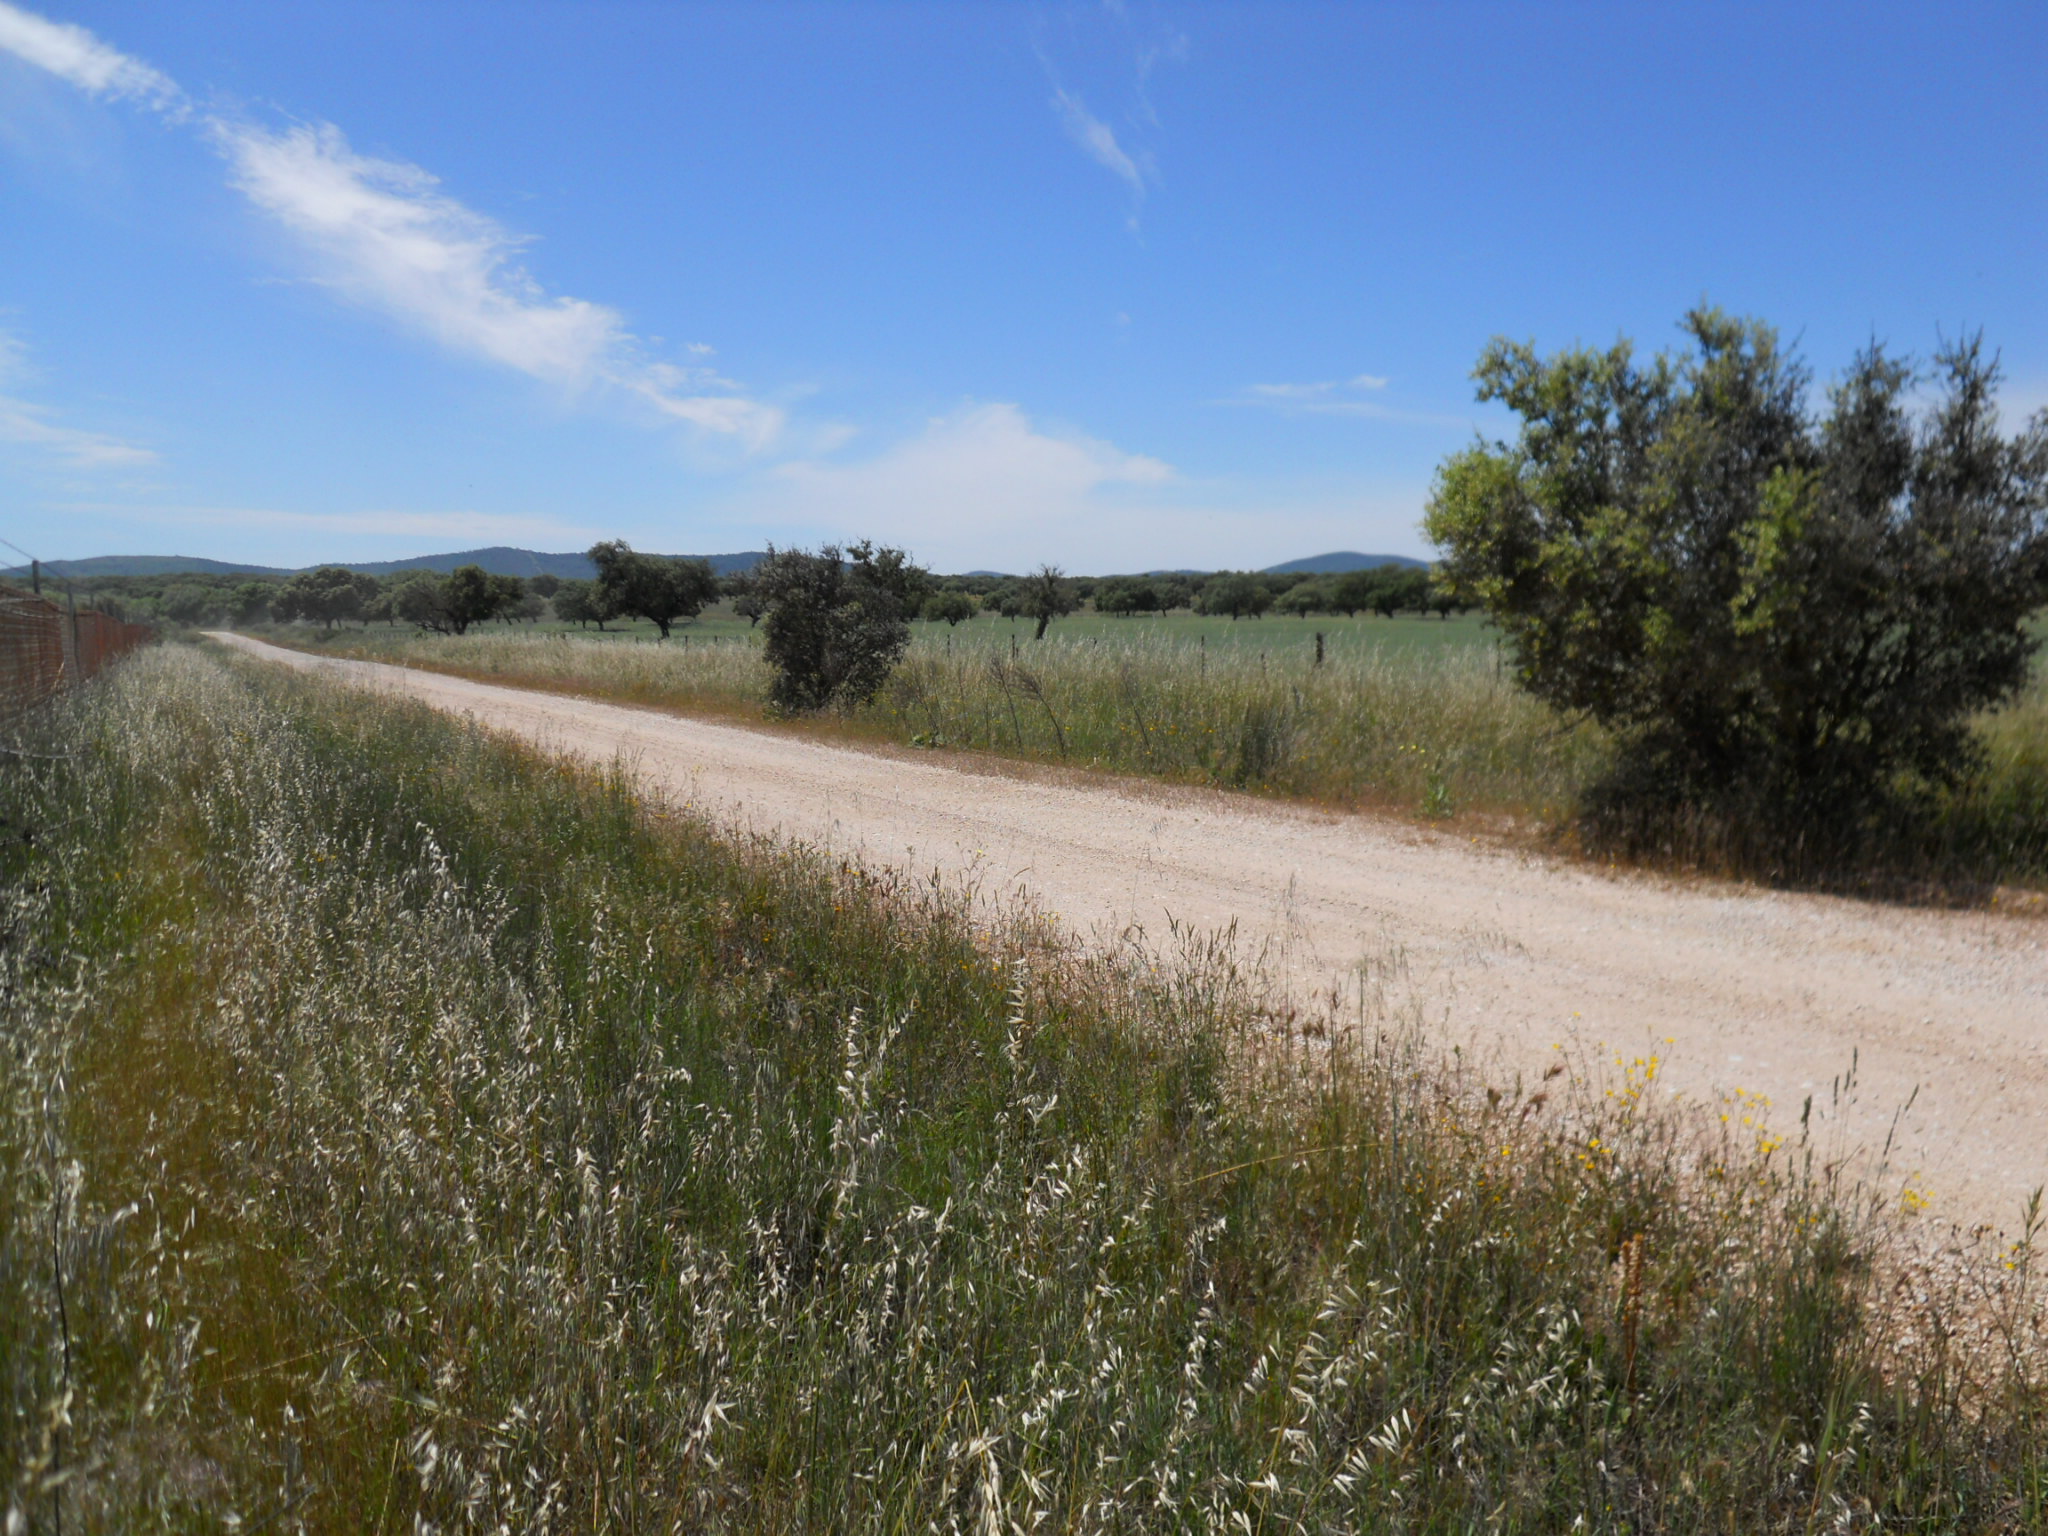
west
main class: Woodland
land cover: Broadleaved woodland
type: broadleaved evergreen forest
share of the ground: 25 - 50 %
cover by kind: broadleaved forest trees 80 %, herbaceous plants 20 %
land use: Forestry
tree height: < 5 m
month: May
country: ES
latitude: 39.2583
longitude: -6.3225
